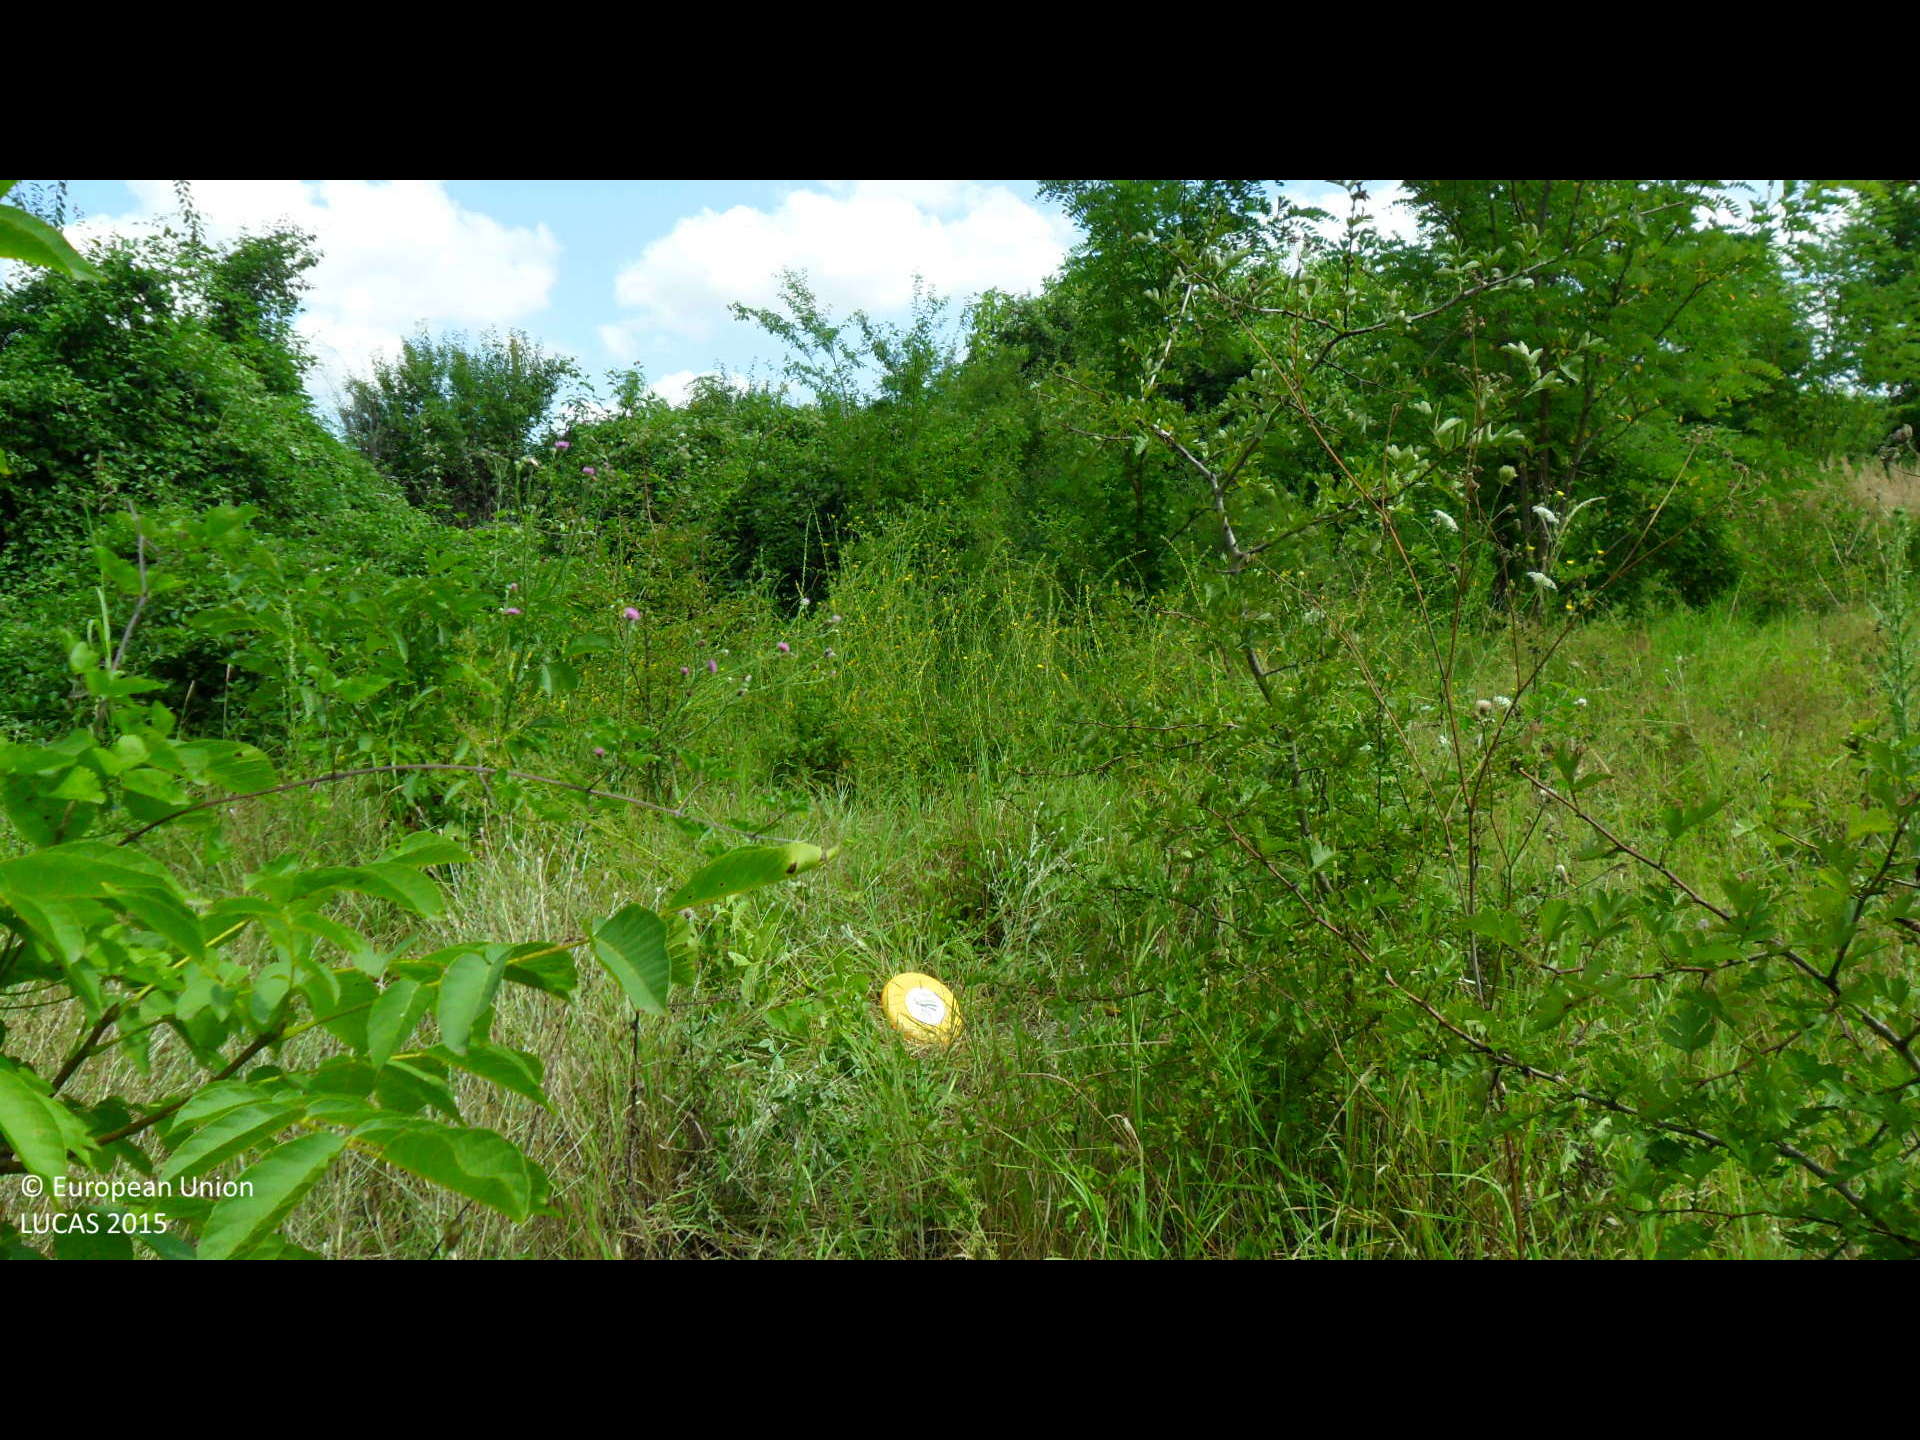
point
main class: Woodland
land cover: Broadleaved woodland
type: mesophytic deciduous forest
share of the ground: 50 - 75 %
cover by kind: broadleaved forest trees 50 %, herbaceous plants 30 %, shrubs 20 %
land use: Residential
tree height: < 5 m
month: August
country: BG
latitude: 43.4299
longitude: 26.3445
